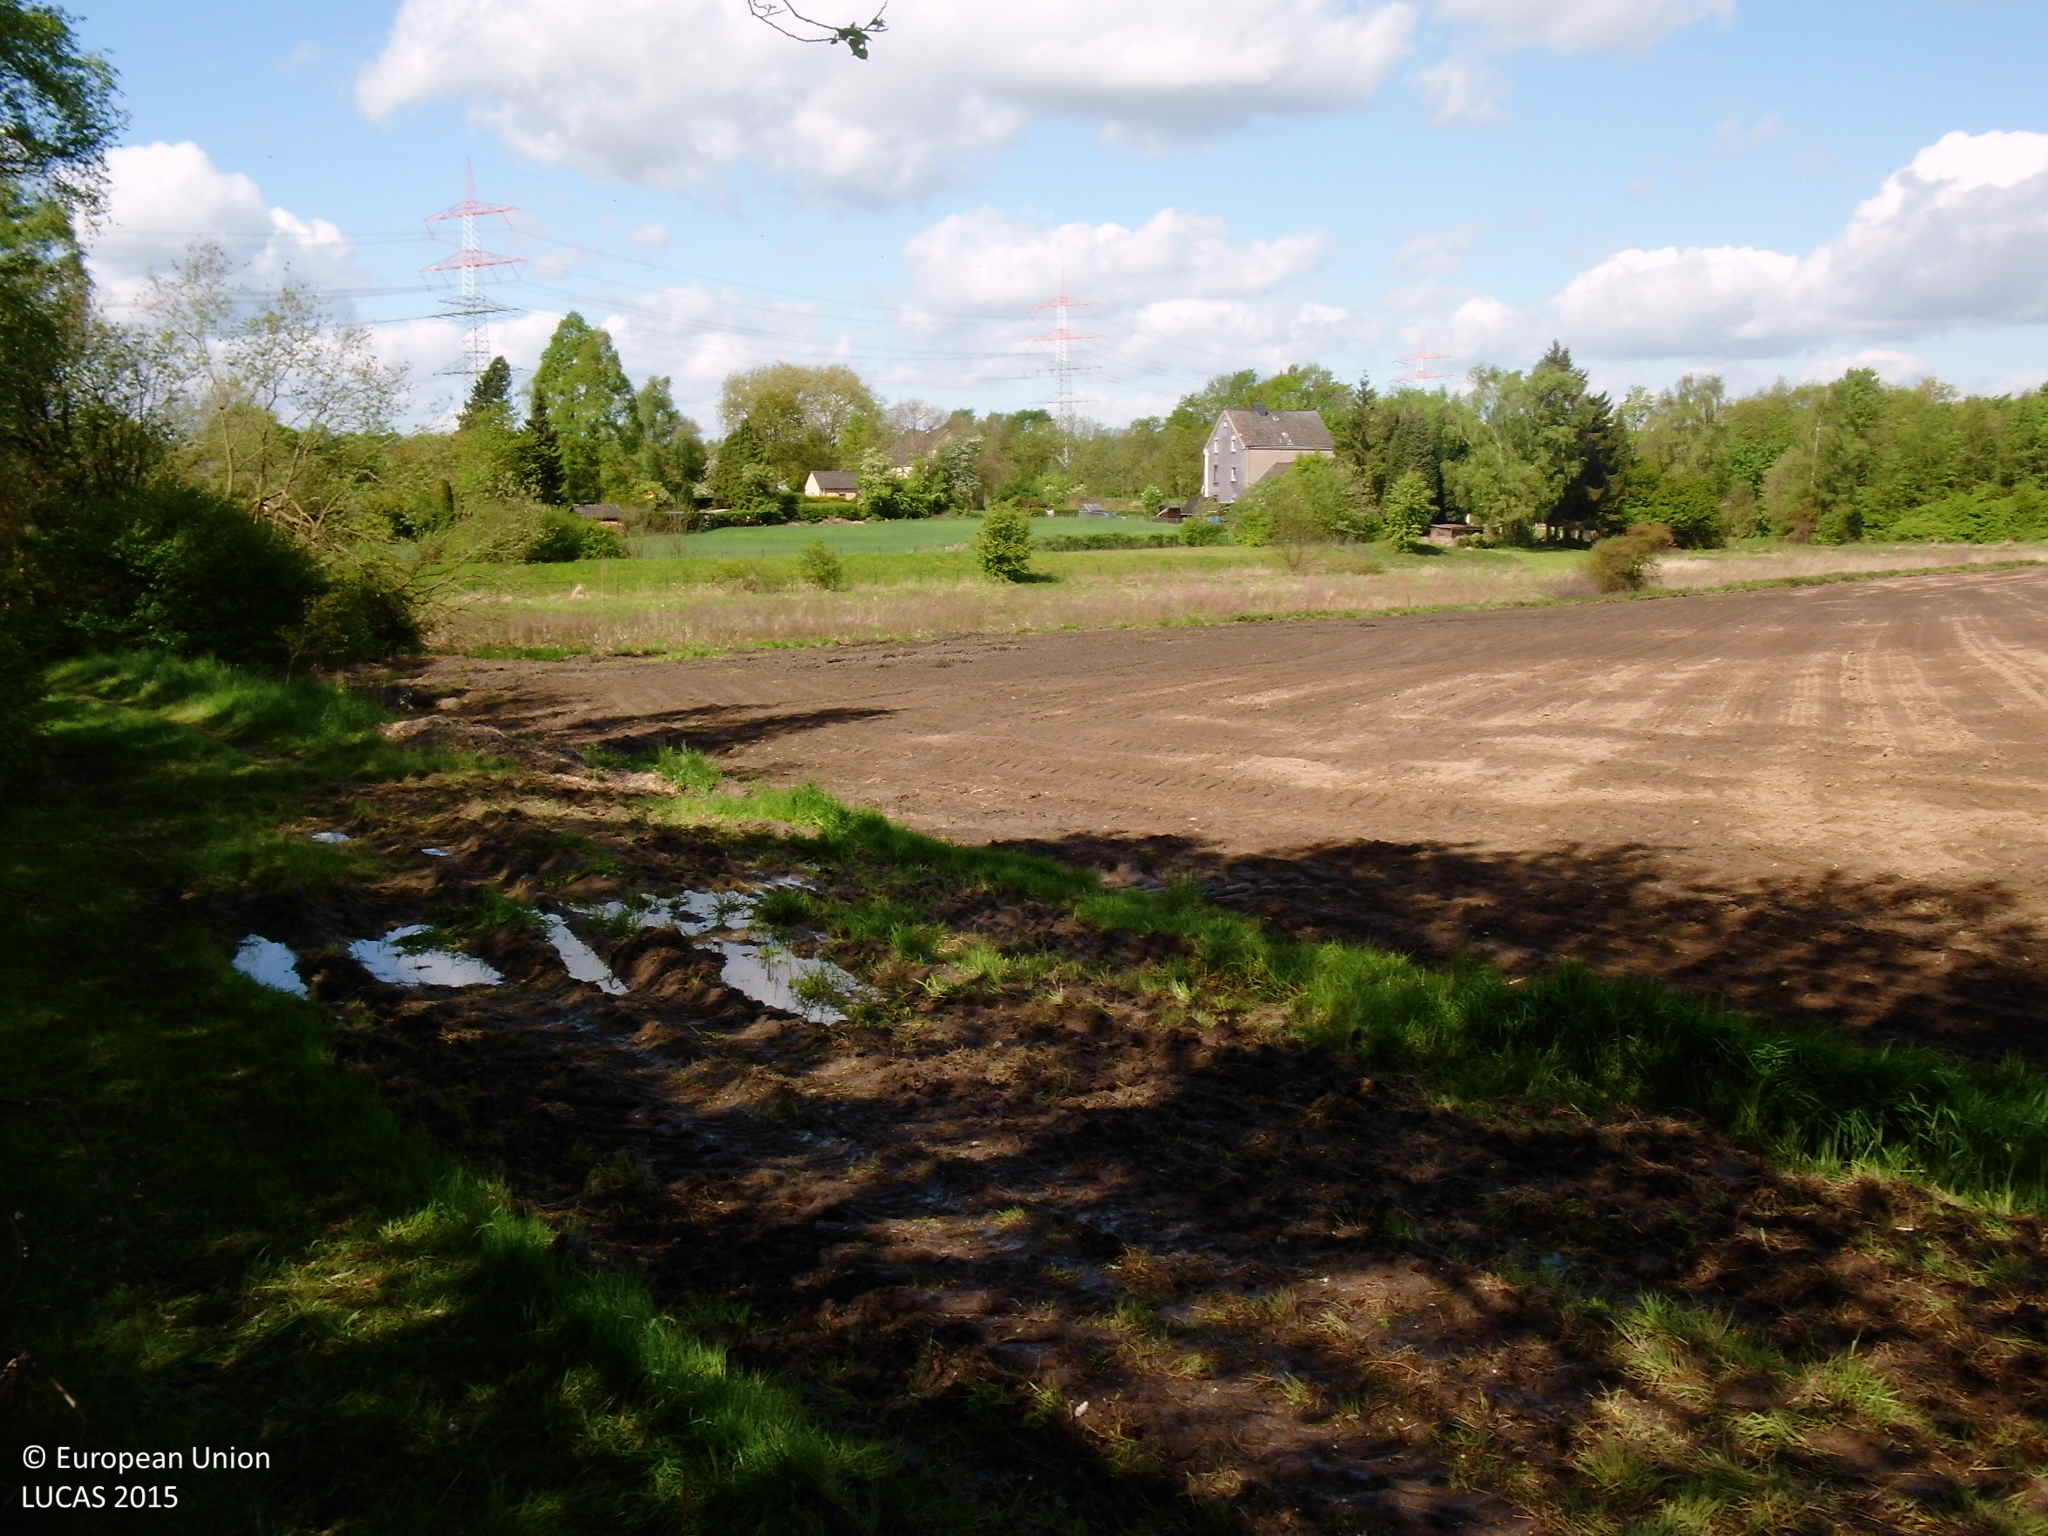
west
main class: Woodland
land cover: Broadleaved woodland
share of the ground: > 75 %
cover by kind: broadleaved forest trees 90 %, herbaceous plants 5 %, unconsolidated bare surface 5 %
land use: Road transport
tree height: > 5 m
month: May
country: DE
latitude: 51.5215
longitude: 7.3916
